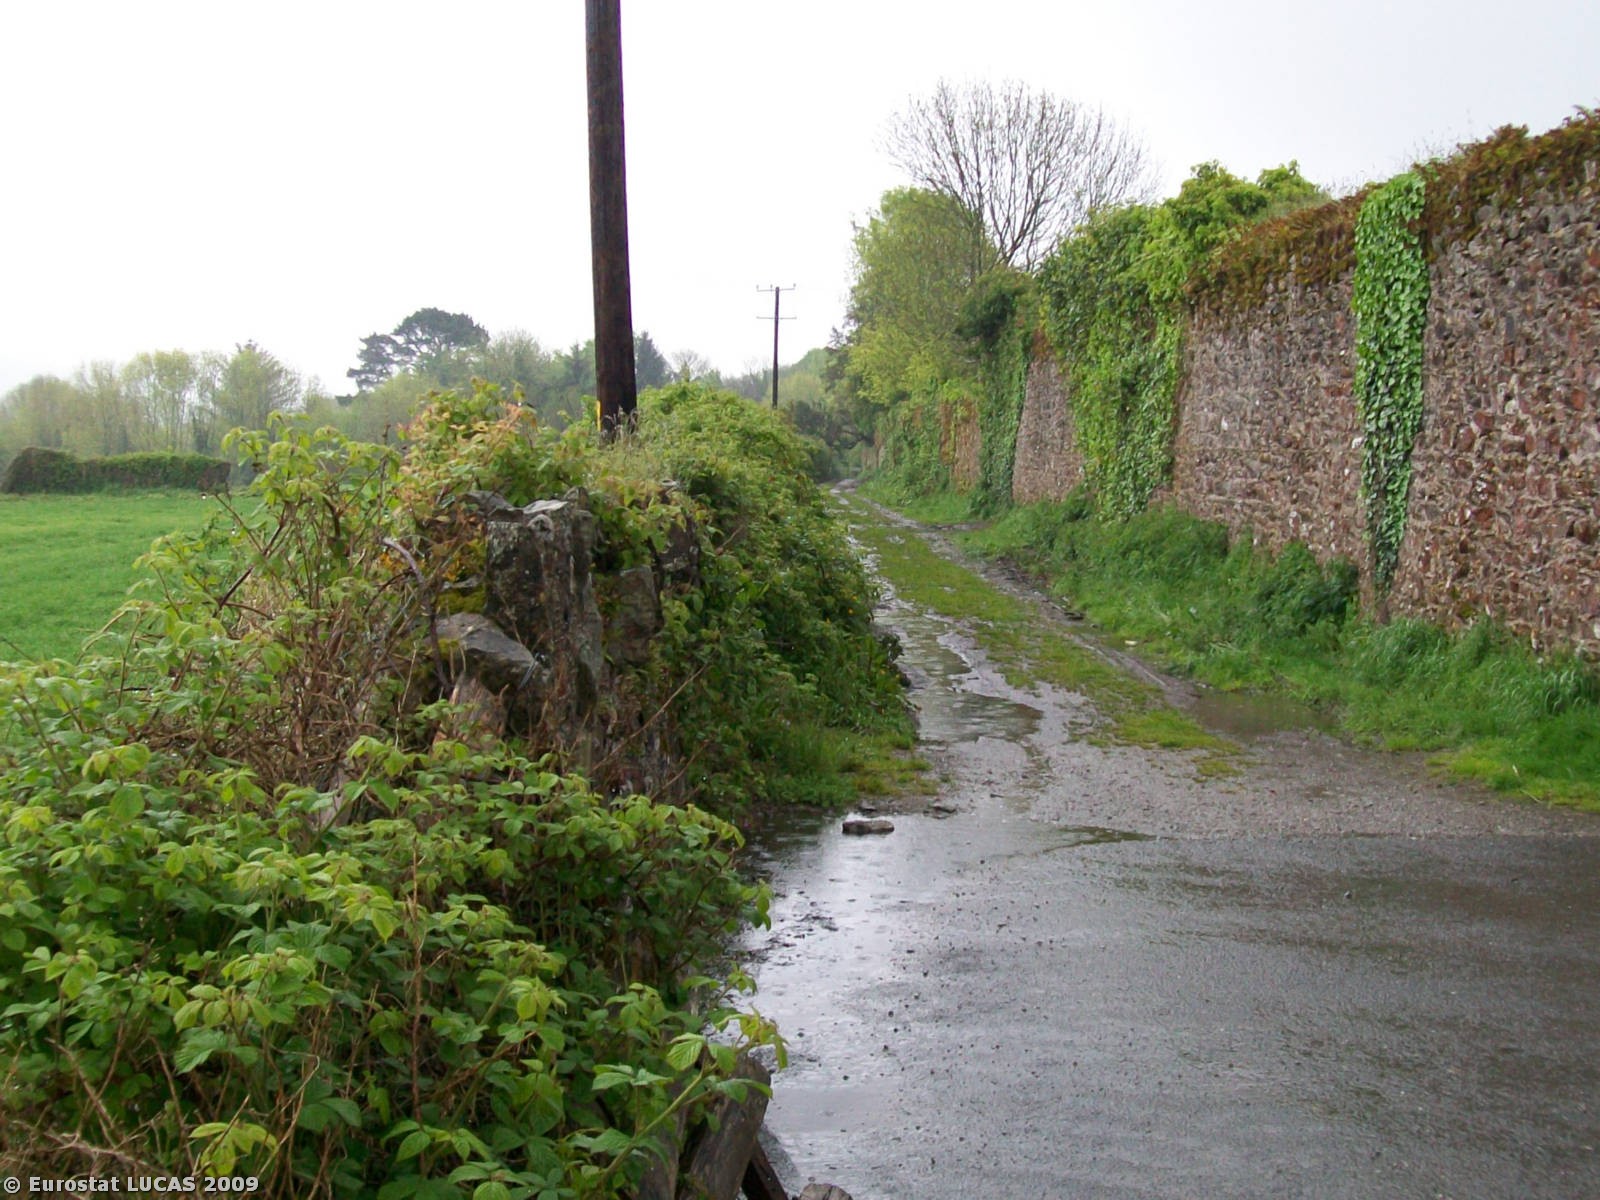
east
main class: Grassland
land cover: Grassland without tree/shrub cover
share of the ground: > 75 %
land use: Agriculture (excluding fallow land and kitchen gardens)
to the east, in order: Grassland without tree/shrub cover; Managed hedges; Grassland without tree/shrub cover; Electric lines; Grassland without tree/shrub cover; Broadleaved woodland
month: May
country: IE
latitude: 52.1397
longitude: -7.9264
